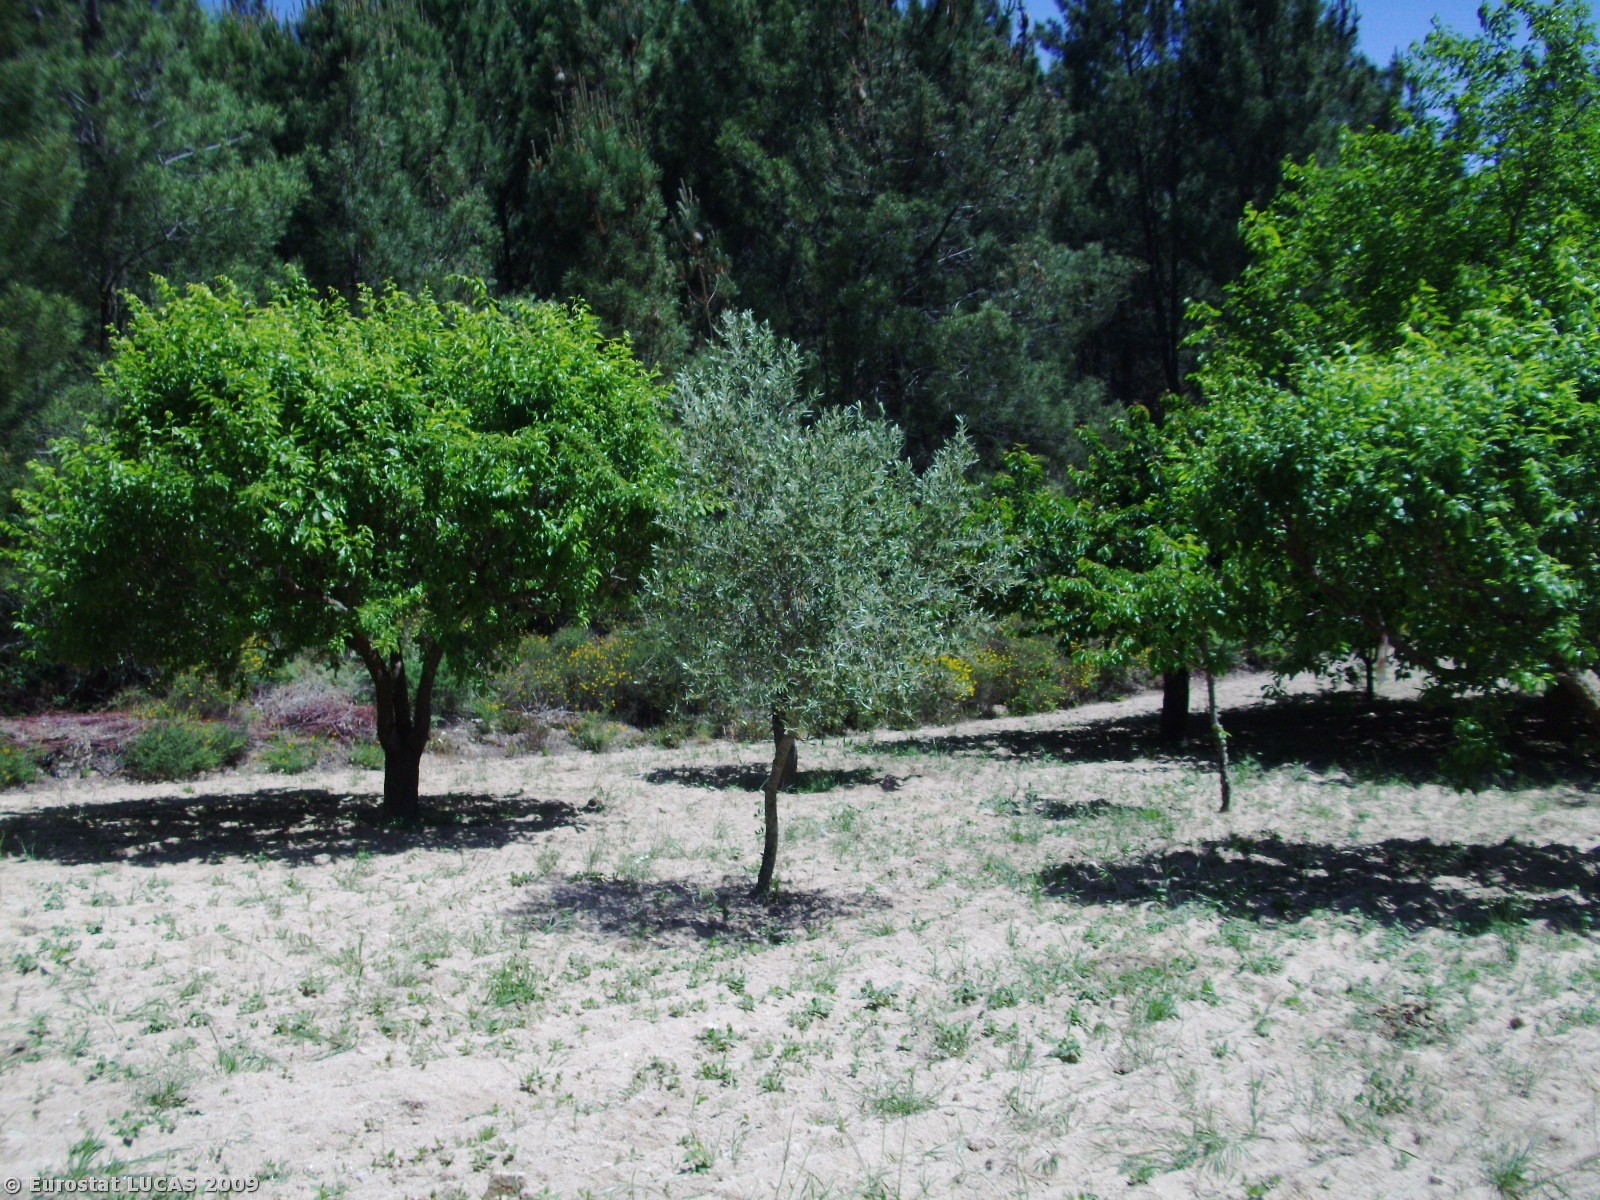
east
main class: Cropland
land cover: Olive groves
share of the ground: 50 - 75 %
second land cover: Cherry fruit
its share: 25 - 50 %
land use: Agriculture (excluding fallow land and kitchen gardens)
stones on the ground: 25 - 50 %
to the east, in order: Olive groves; Cherry fruit; Dry stone walls; Broadleaved woodland; Shrubland with sparse tree cover; Tracks; Shrubland with sparse tree cover; Bare land; Shrubland with sparse tree cover; Bare land; Tracks; Shrubland with sparse tree cover
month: May
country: PT
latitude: 40.8176
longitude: -7.3145
